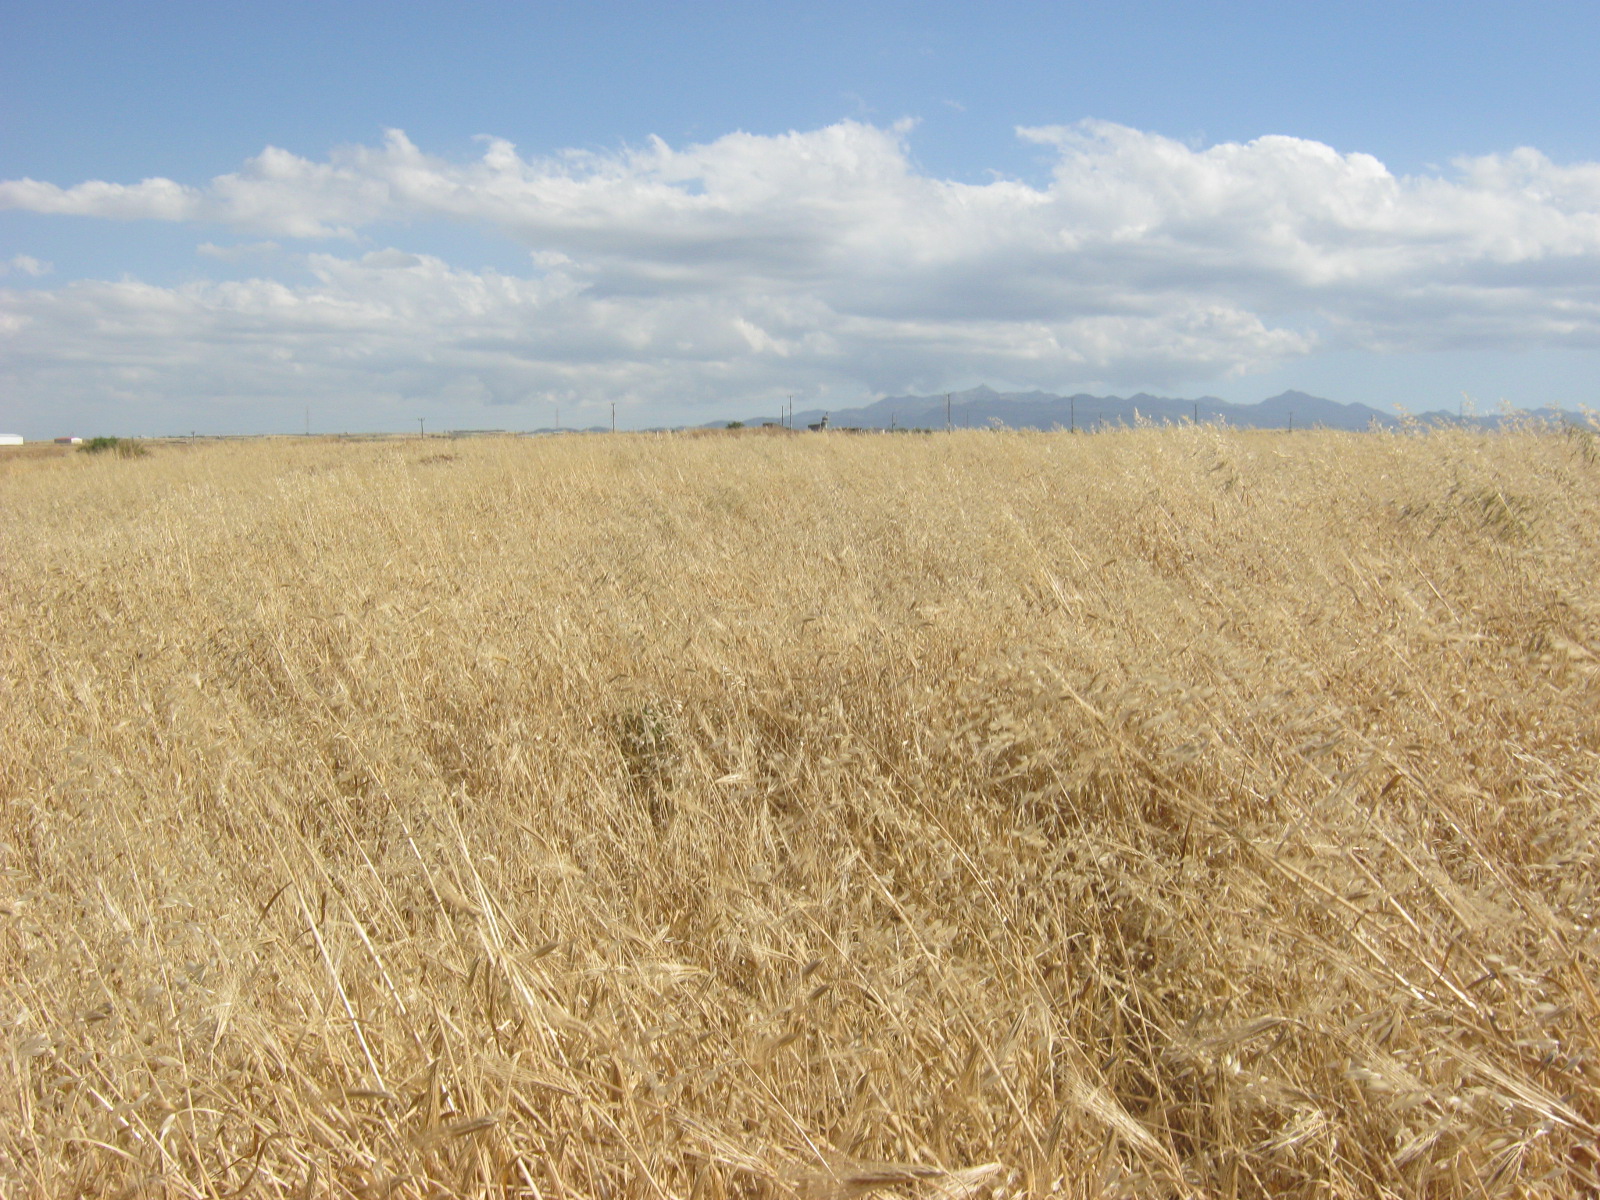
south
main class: Cropland
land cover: Barley
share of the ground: > 75 %
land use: Agriculture (excluding fallow land and kitchen gardens)
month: May
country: CY
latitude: 35.1244
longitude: 33.1742
